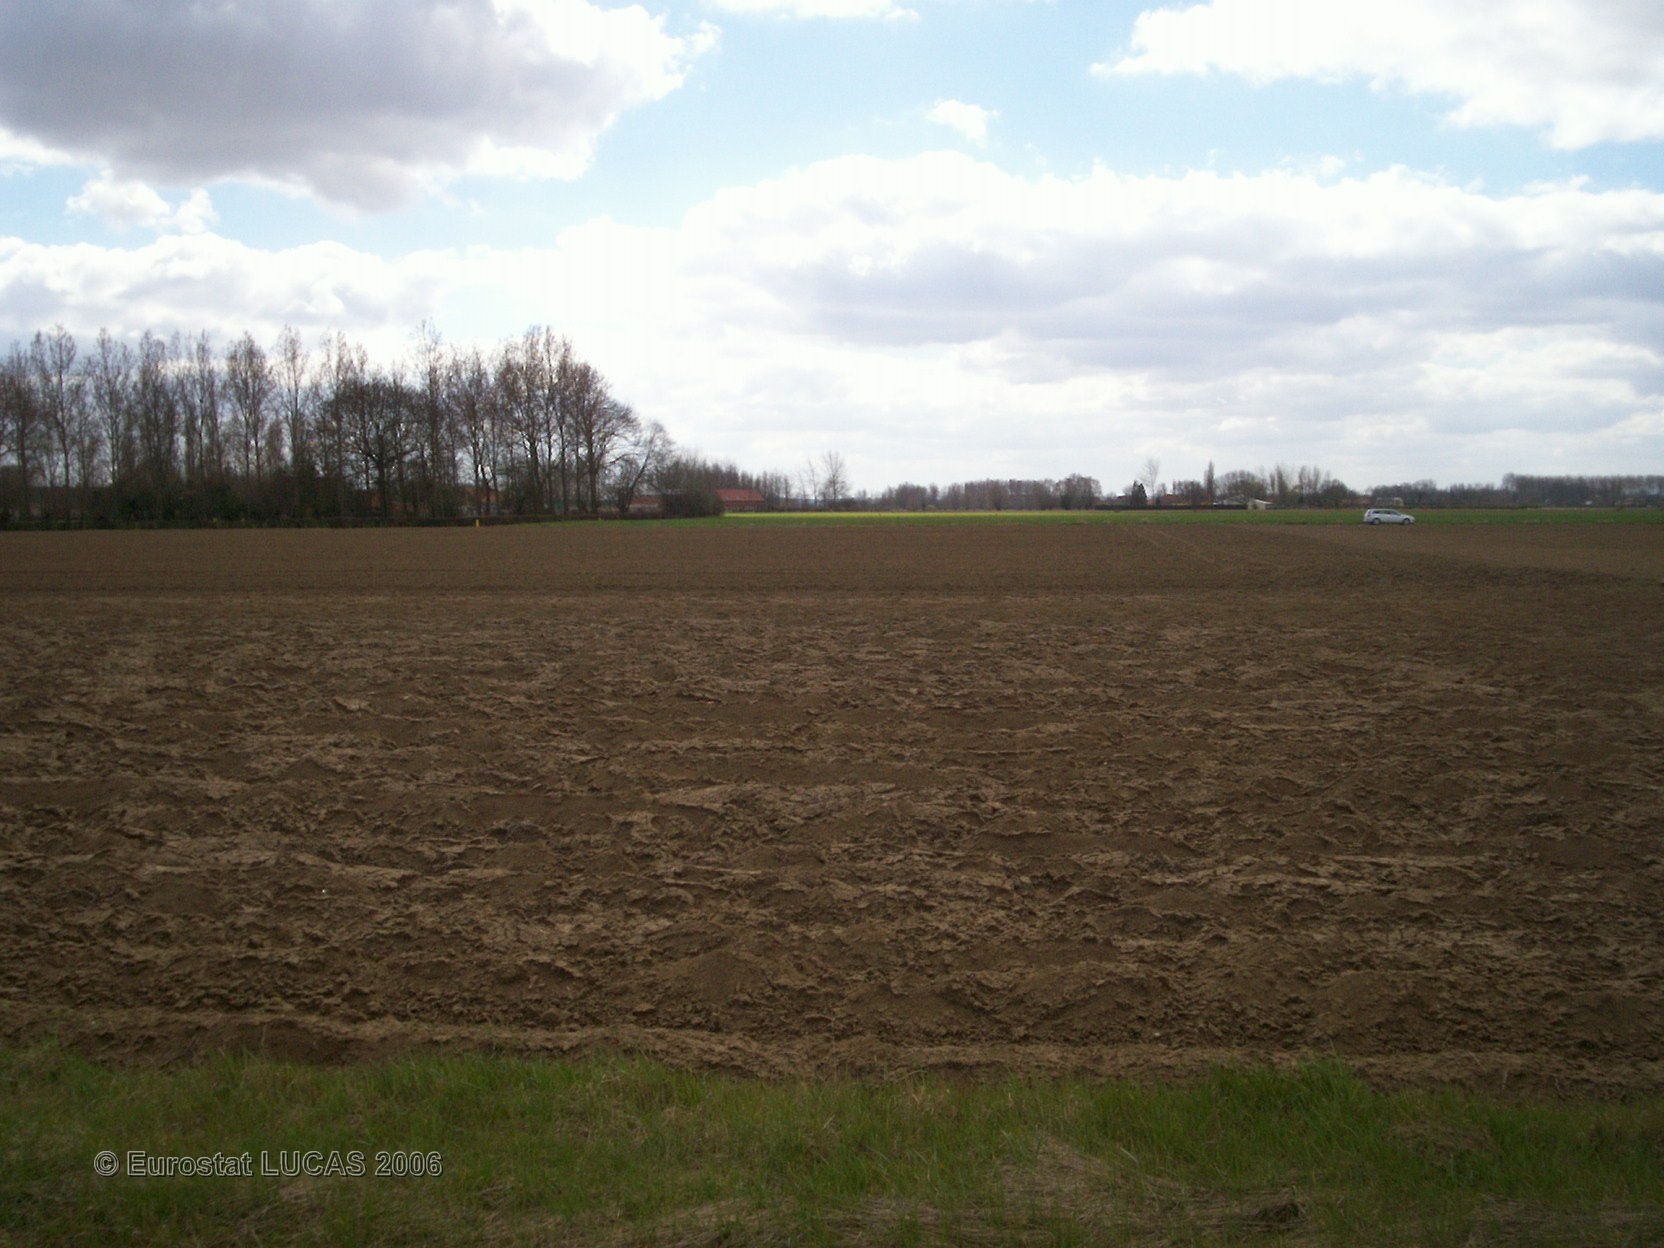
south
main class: Grassland
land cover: Grassland without tree/shrub cover
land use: Agriculture (excluding fallow land and kitchen gardens)
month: April
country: FR
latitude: 50.6116
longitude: 2.5970
